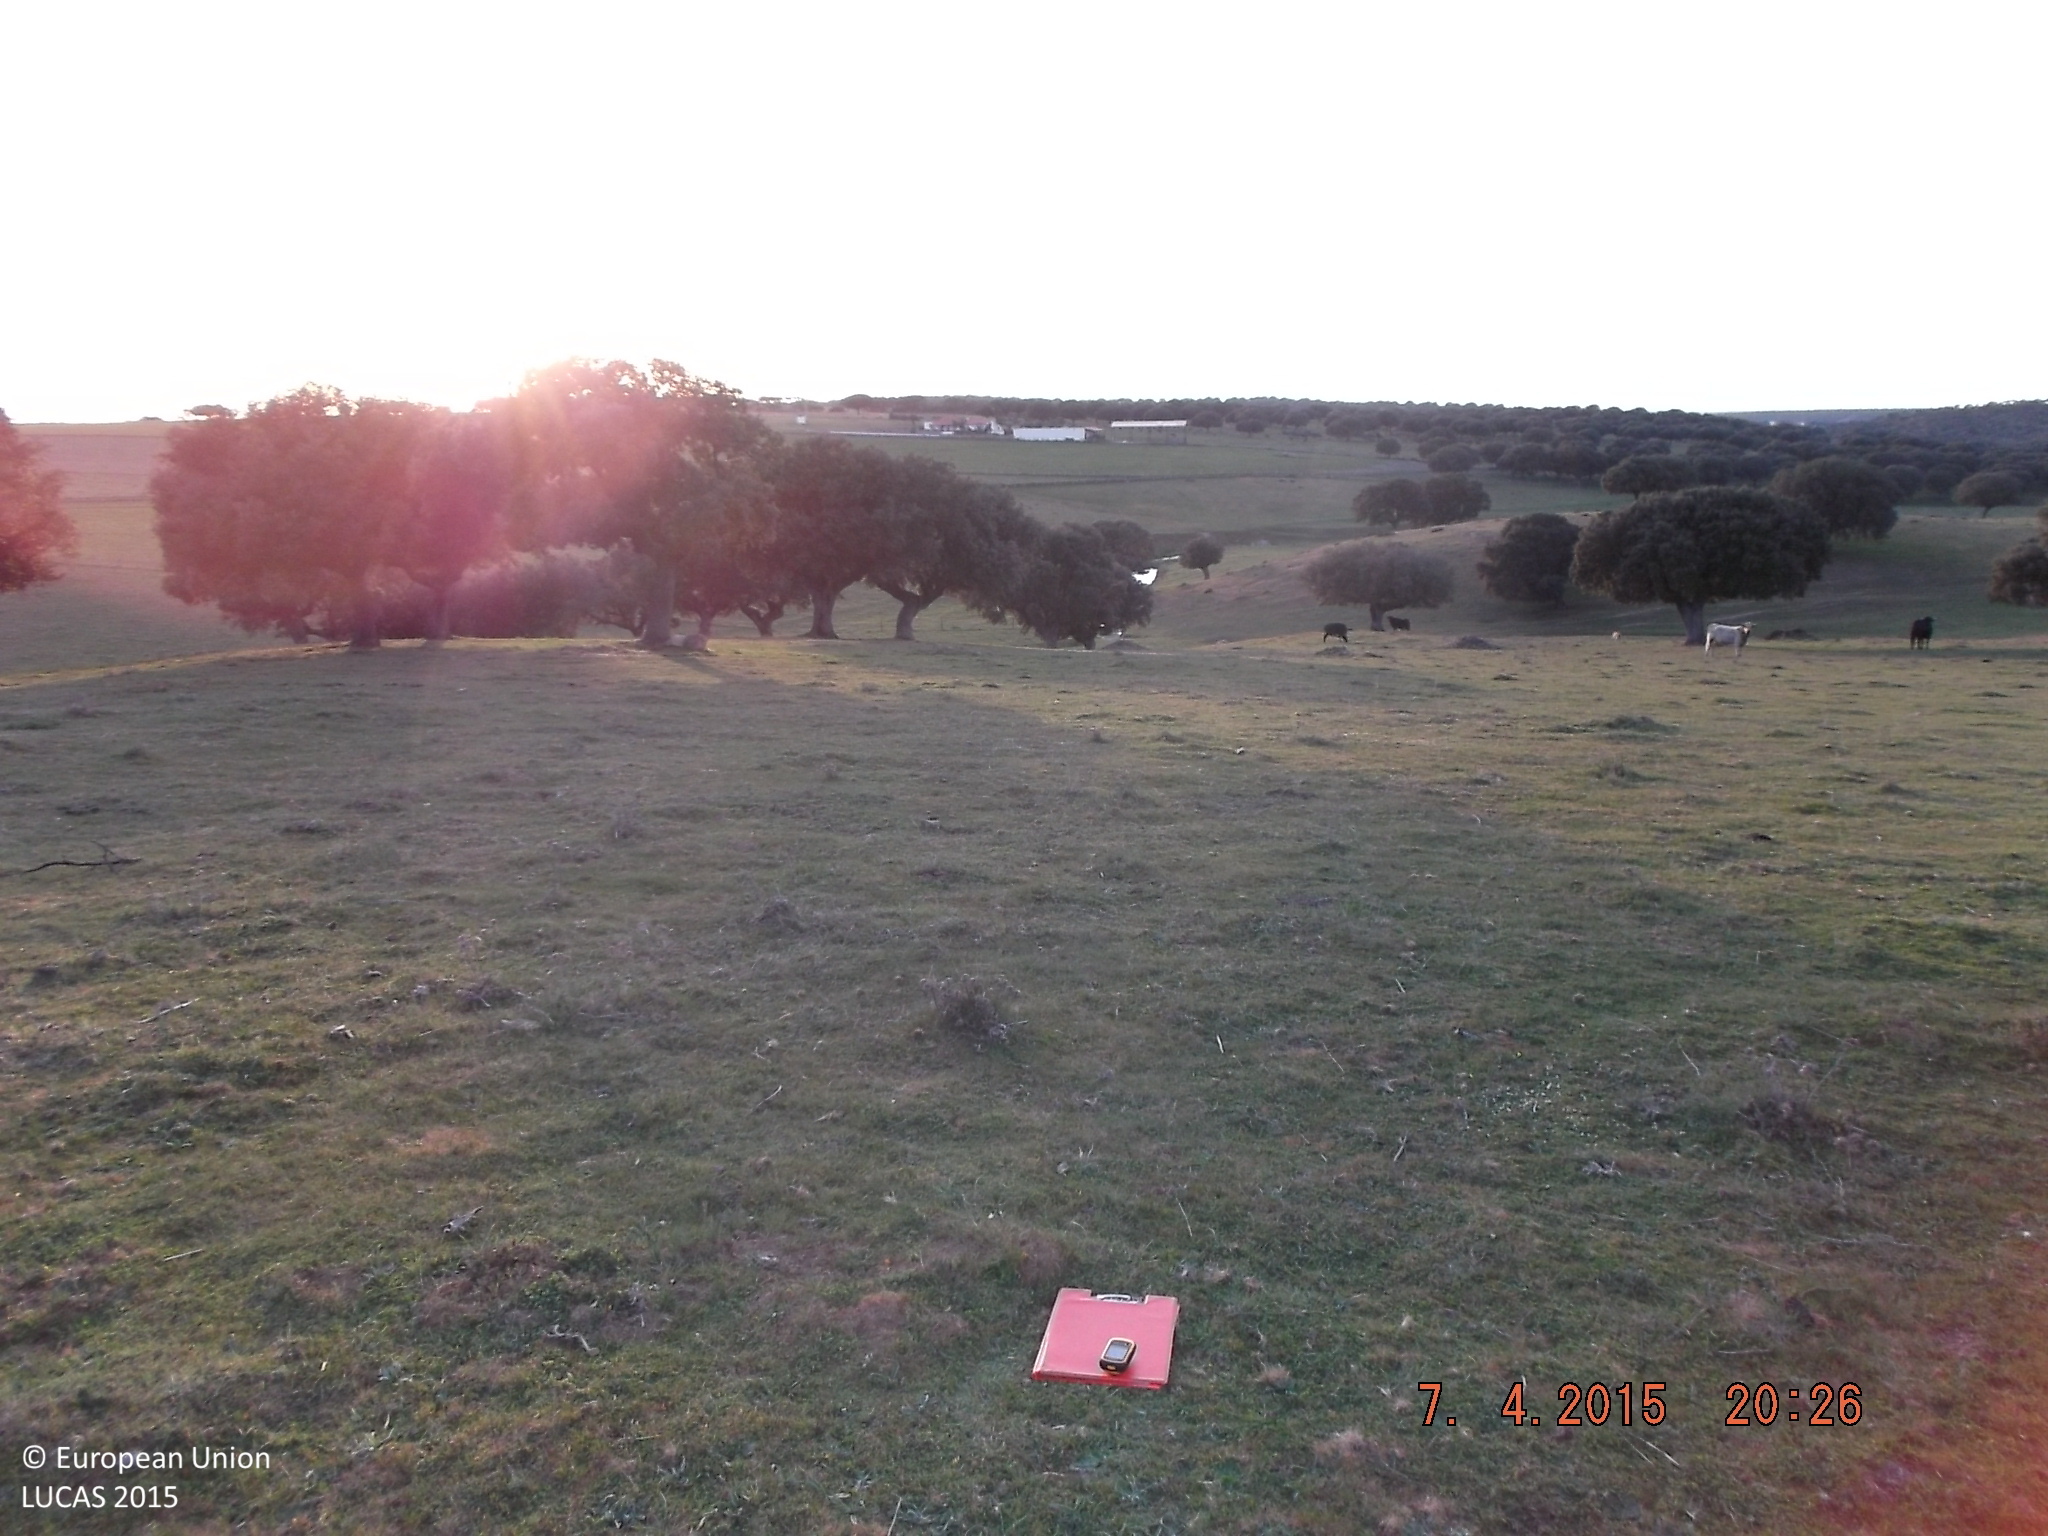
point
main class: Grassland
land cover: Grassland without tree/shrub cover
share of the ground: > 75 %
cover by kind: herbaceous plants 100 %
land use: Agriculture (excluding fallow land and kitchen gardens)
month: April
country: ES
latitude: 40.7862
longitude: -5.8752
